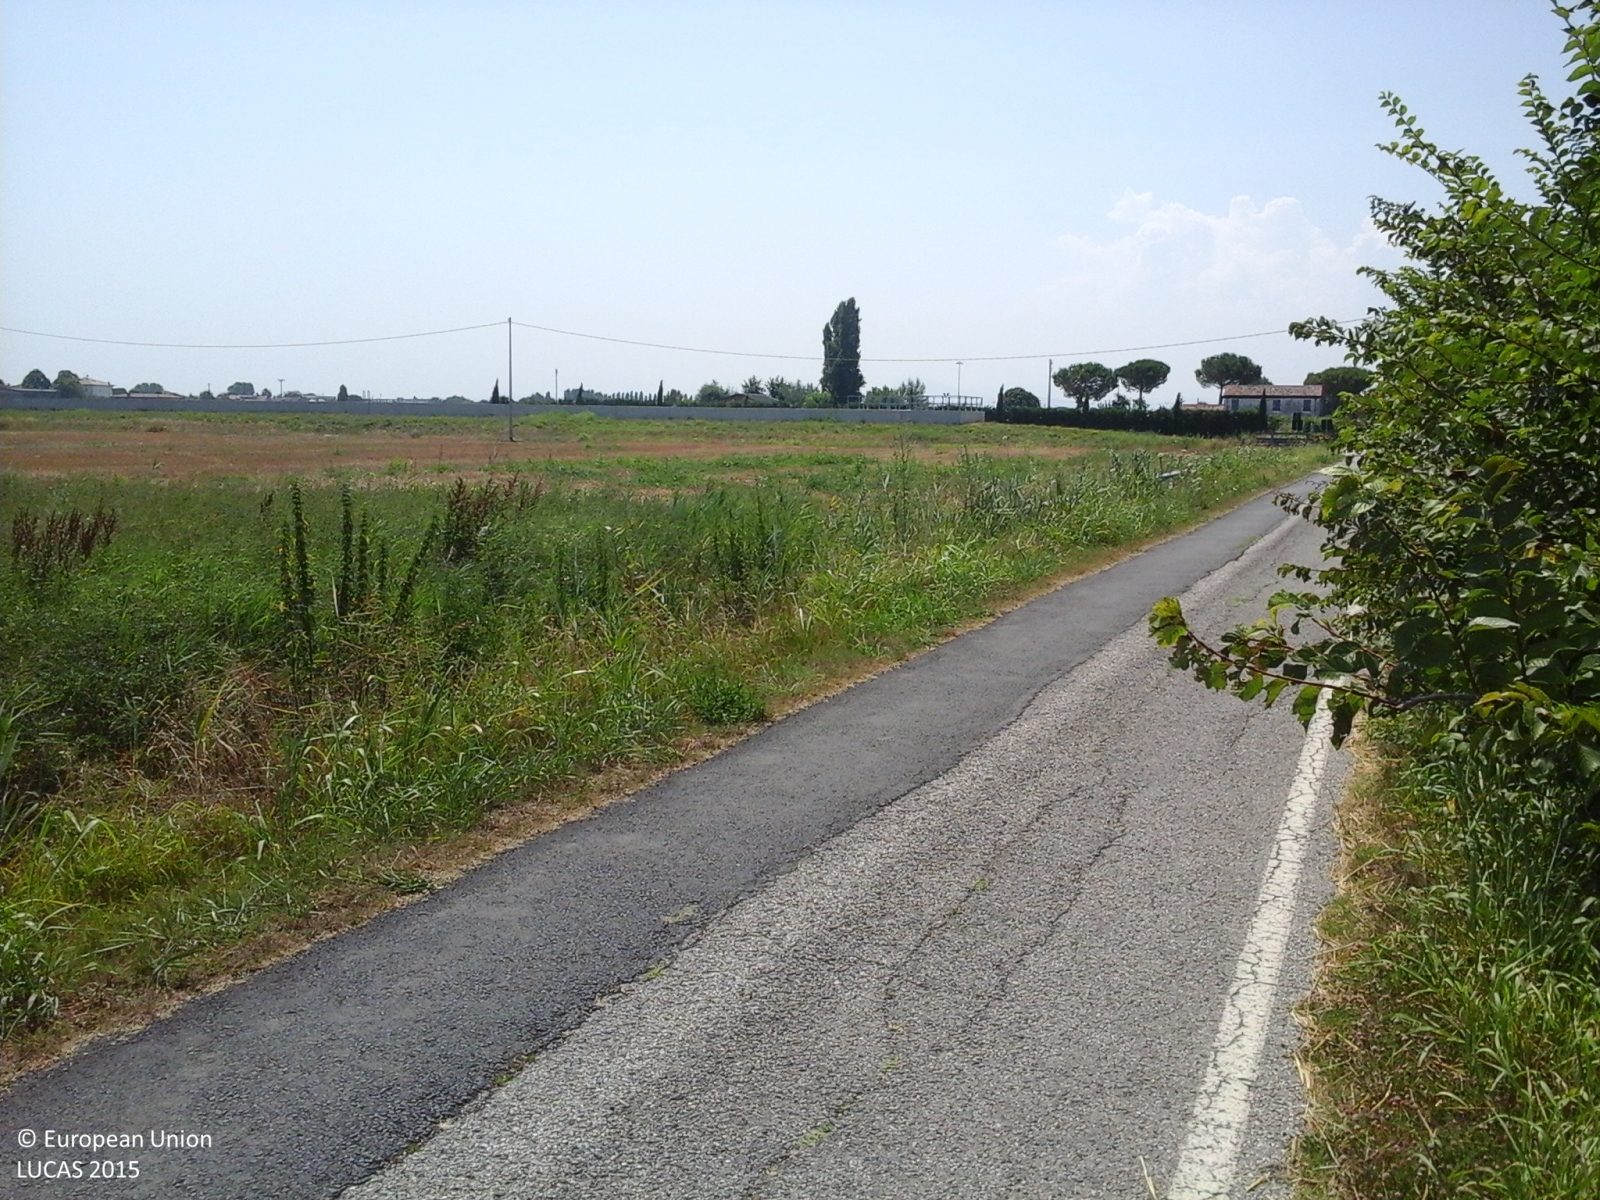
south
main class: Cropland
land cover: Other cereals
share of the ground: > 75 %
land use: Agriculture (excluding fallow land and kitchen gardens)
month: July
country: IT
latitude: 44.1242
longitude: 12.4065
